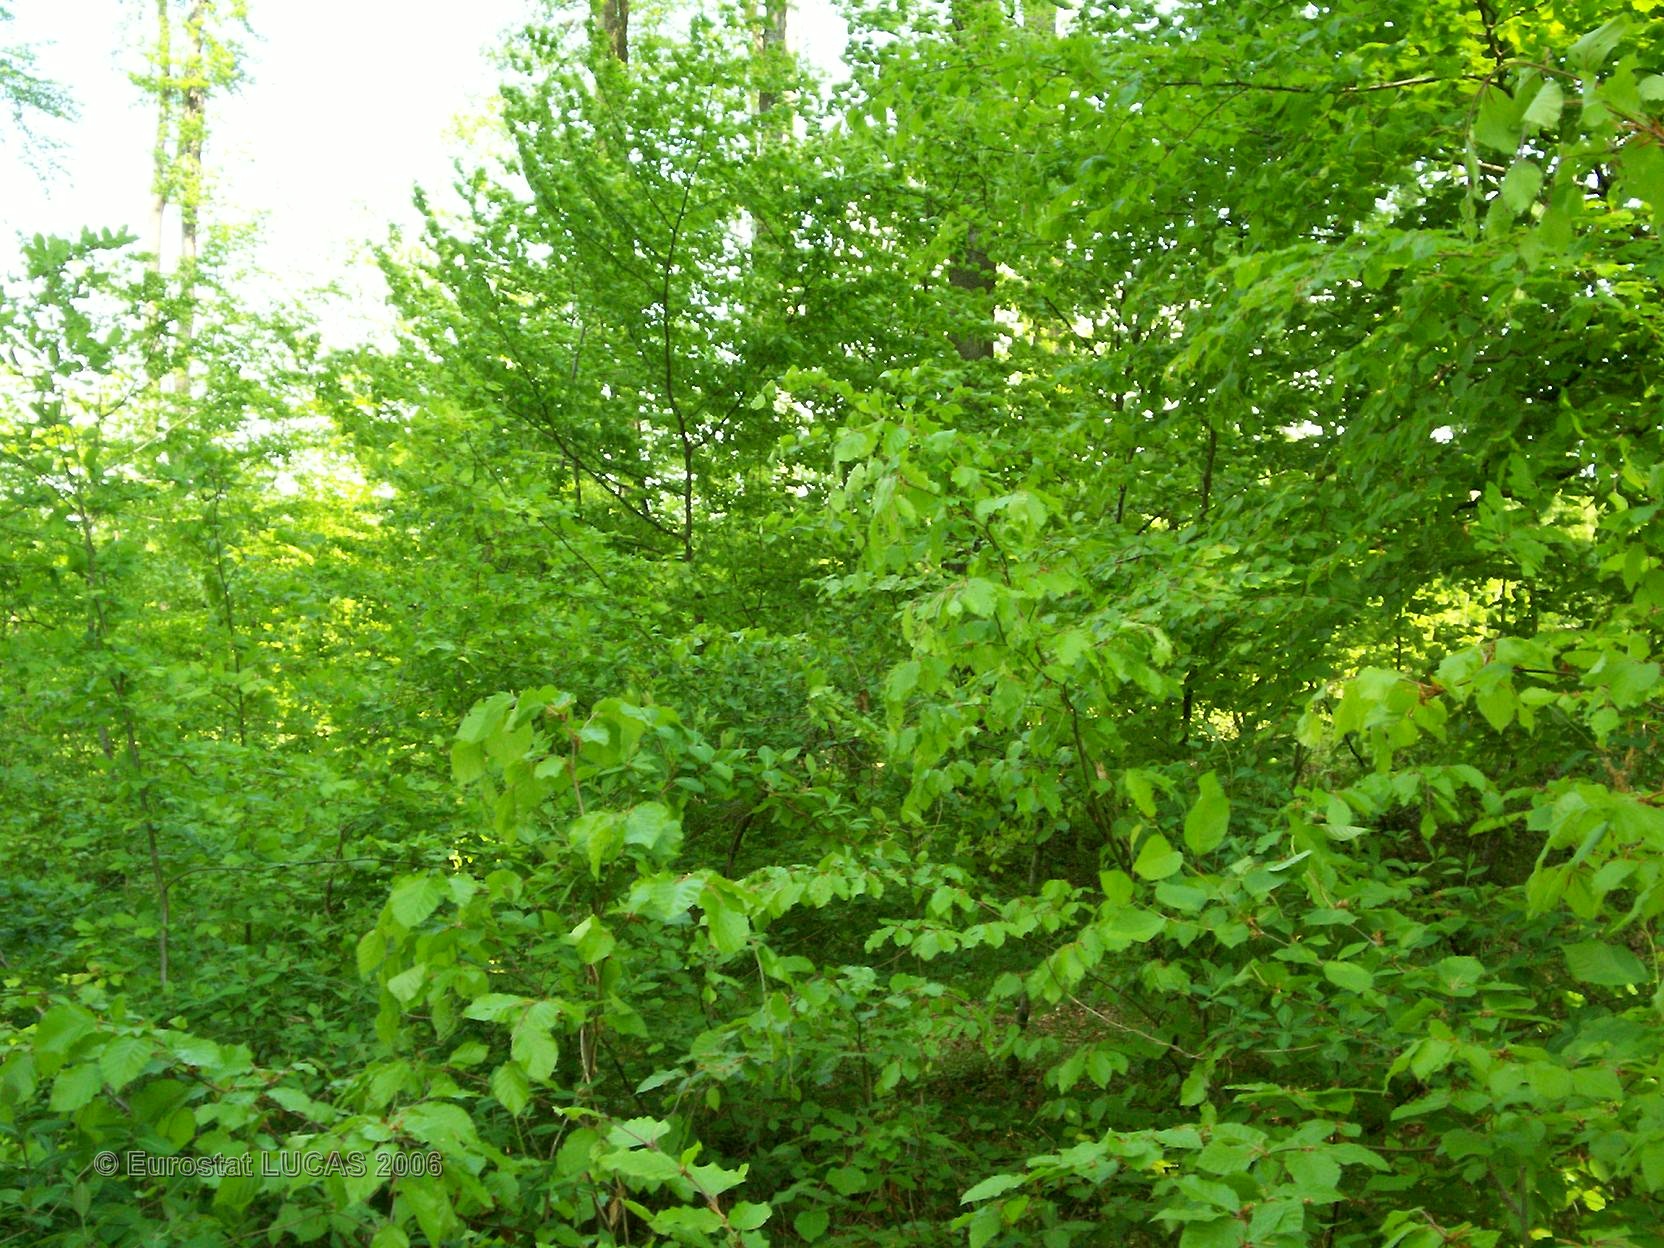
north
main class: Woodland
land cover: Broadleaved forest
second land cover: Grassland with sparse tree/shrub cover
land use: Forestry
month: May
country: FR
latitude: 47.7002
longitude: 7.1365
